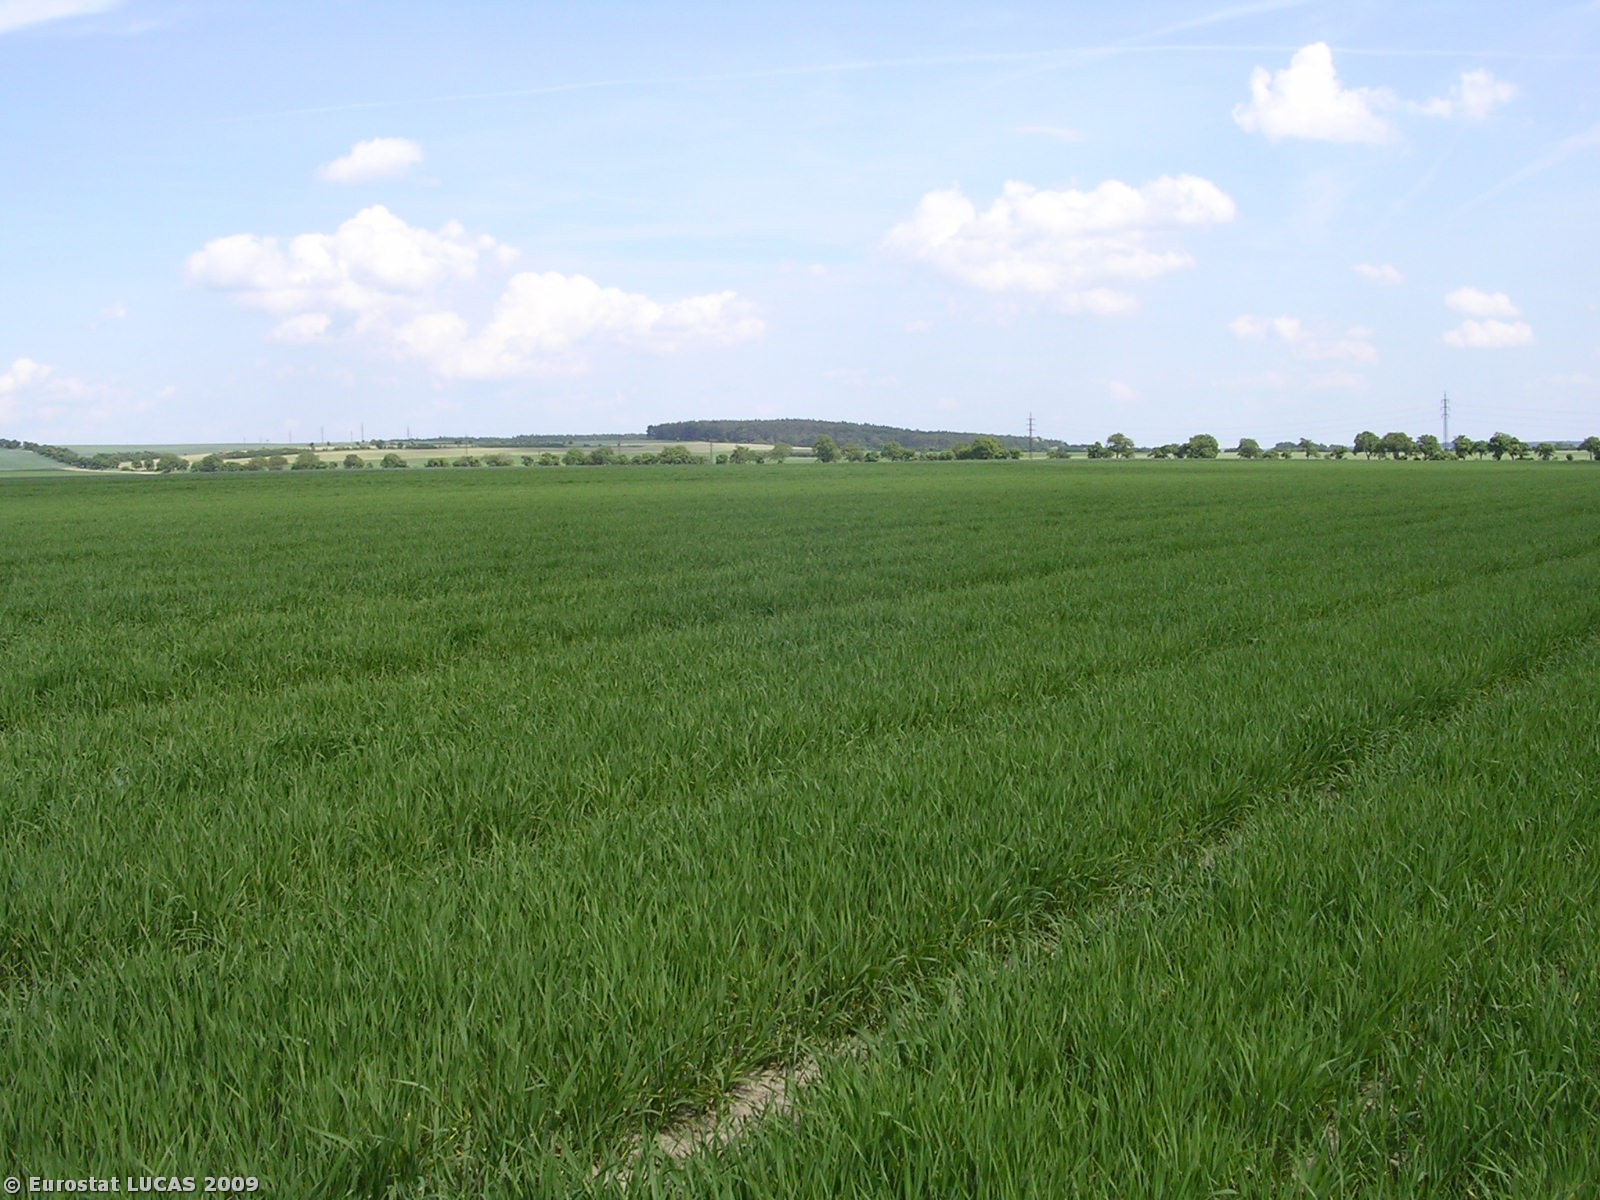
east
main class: Cropland
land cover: Barley
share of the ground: > 75 %
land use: Agriculture (excluding fallow land and kitchen gardens)
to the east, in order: Barley; Common wheat
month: May
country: CZ
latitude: 50.2674
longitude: 14.7020
